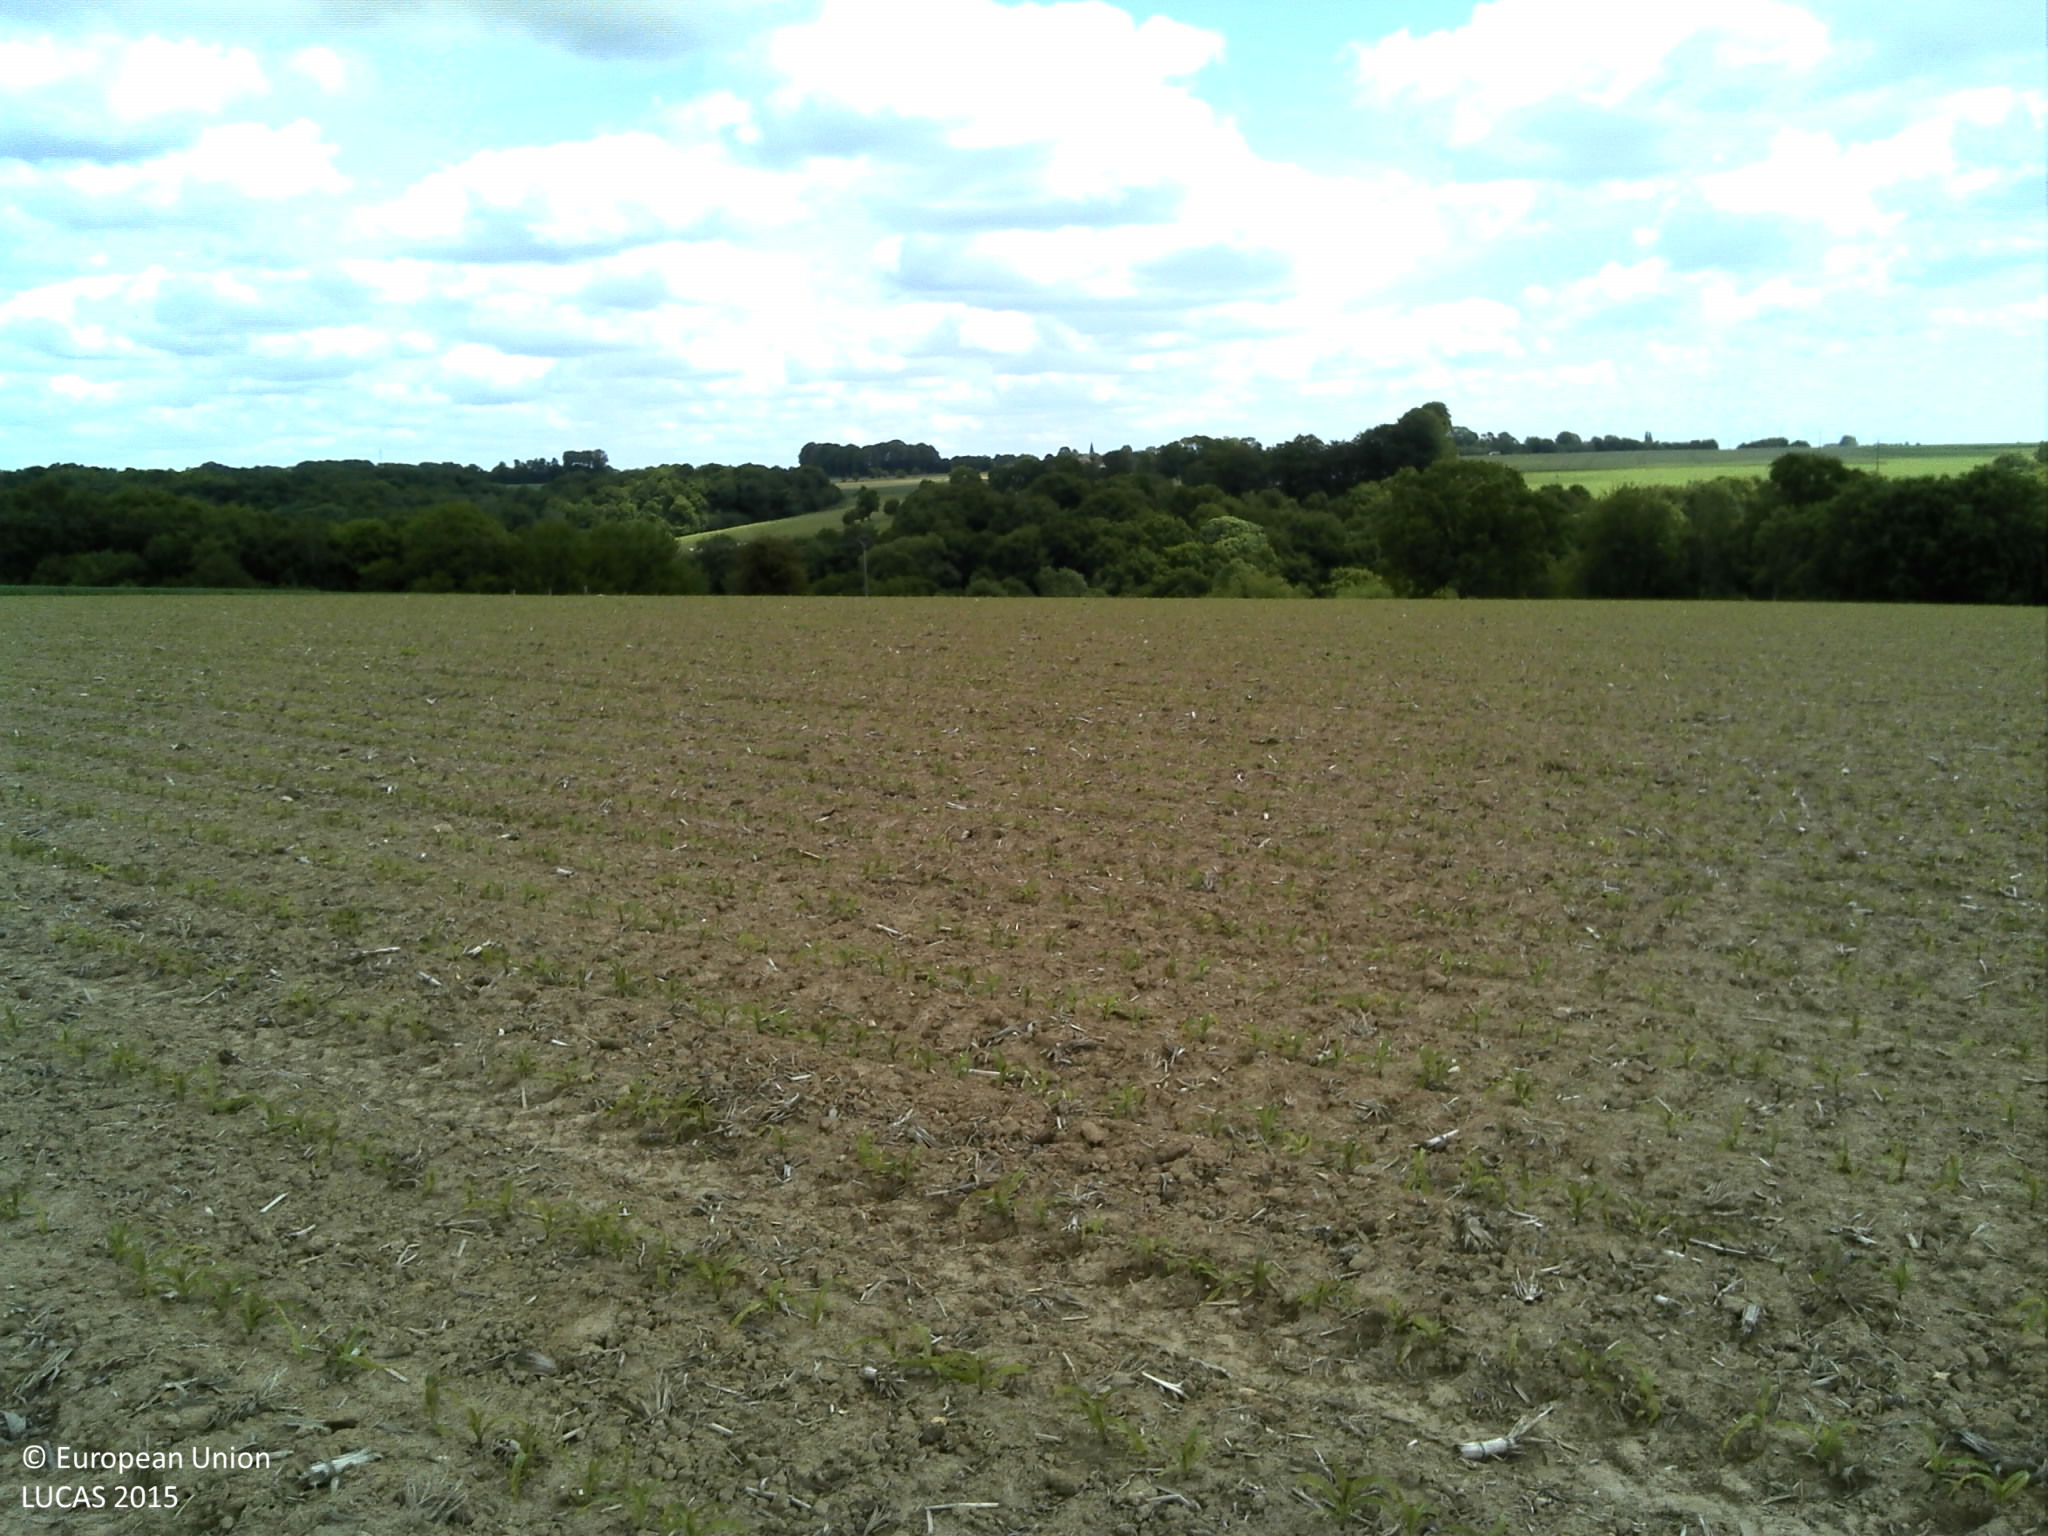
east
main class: Cropland
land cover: Maize
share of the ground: < 10 %
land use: Agriculture (excluding fallow land and kitchen gardens)
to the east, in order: Maize; Fences; Grassland without tree/shrub cover
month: May
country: FR
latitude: 49.5230
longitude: 0.5941
